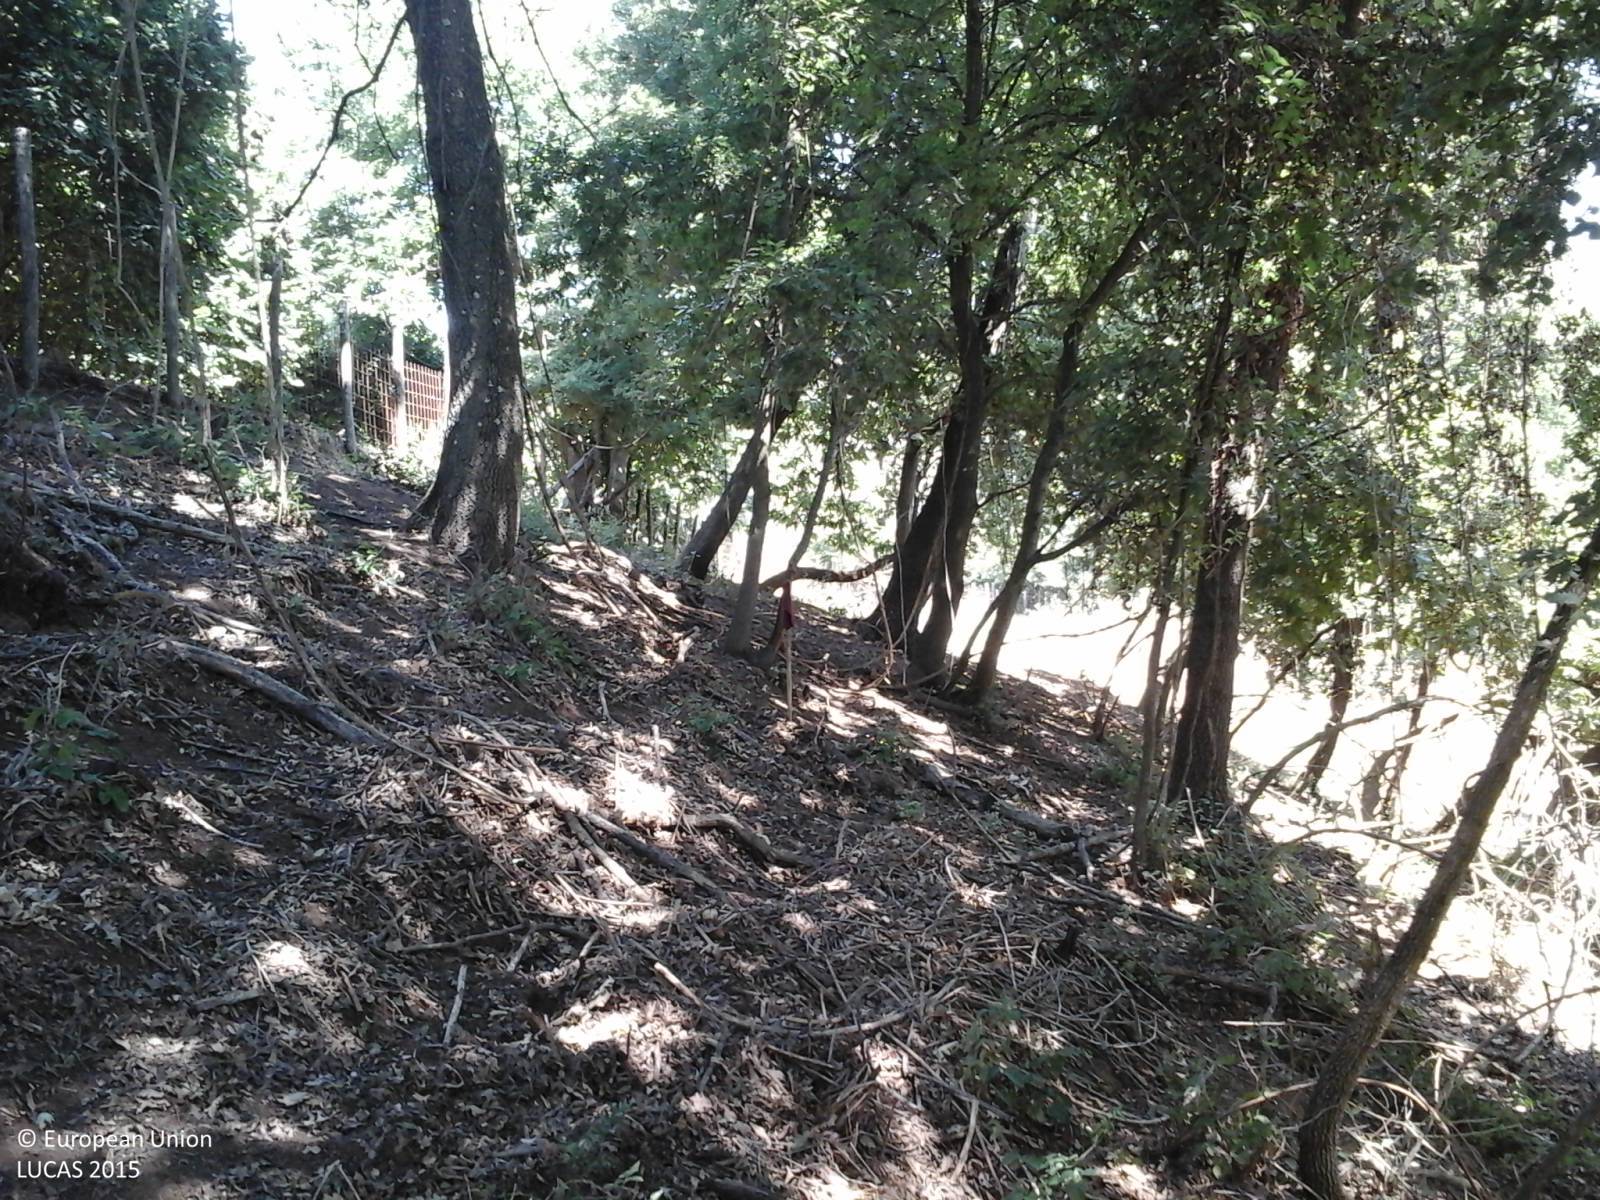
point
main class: Woodland
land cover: Broadleaved woodland
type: thermophilous deciduous forest
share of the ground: > 75 %
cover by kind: broadleaved forest trees 100 %
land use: Agriculture (excluding fallow land and kitchen gardens)
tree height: > 5 m
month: August
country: IT
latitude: 42.2138
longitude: 12.2331
